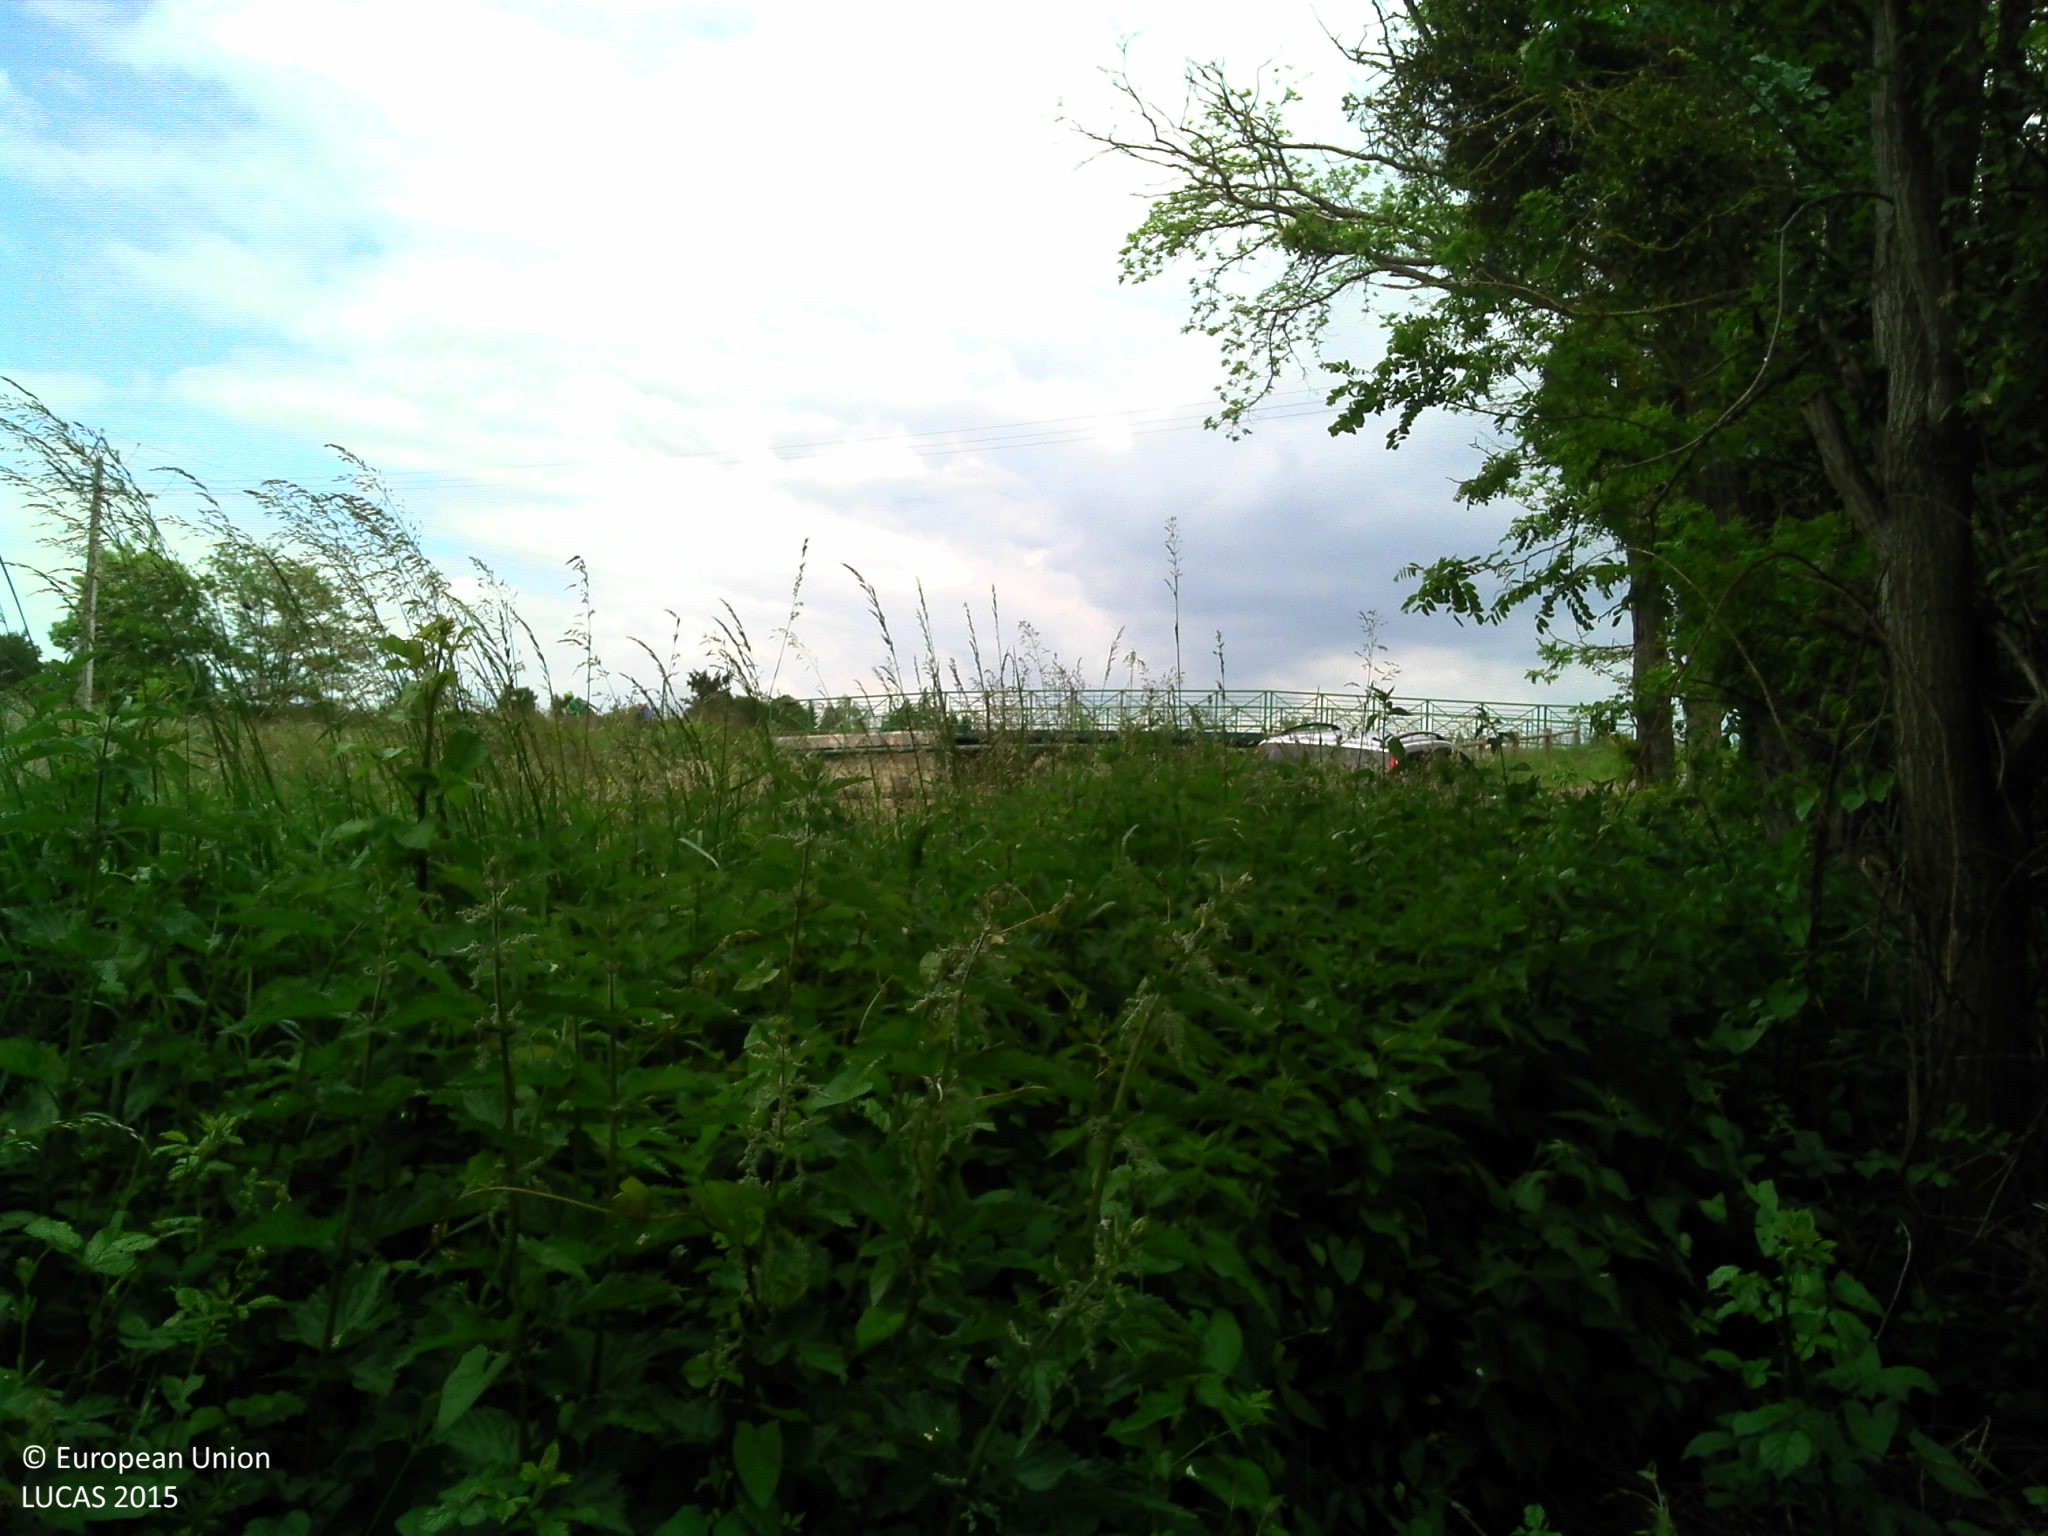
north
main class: Woodland
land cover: Broadleaved woodland
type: boreal forest
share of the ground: > 75 %
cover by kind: broadleaved forest trees 70 %, shrubs 15 %, herbaceous plants 15 %
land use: Semi-natural and natural areas not in use
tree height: > 5 m
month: May
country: FR
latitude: 47.3791
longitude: 2.8816
